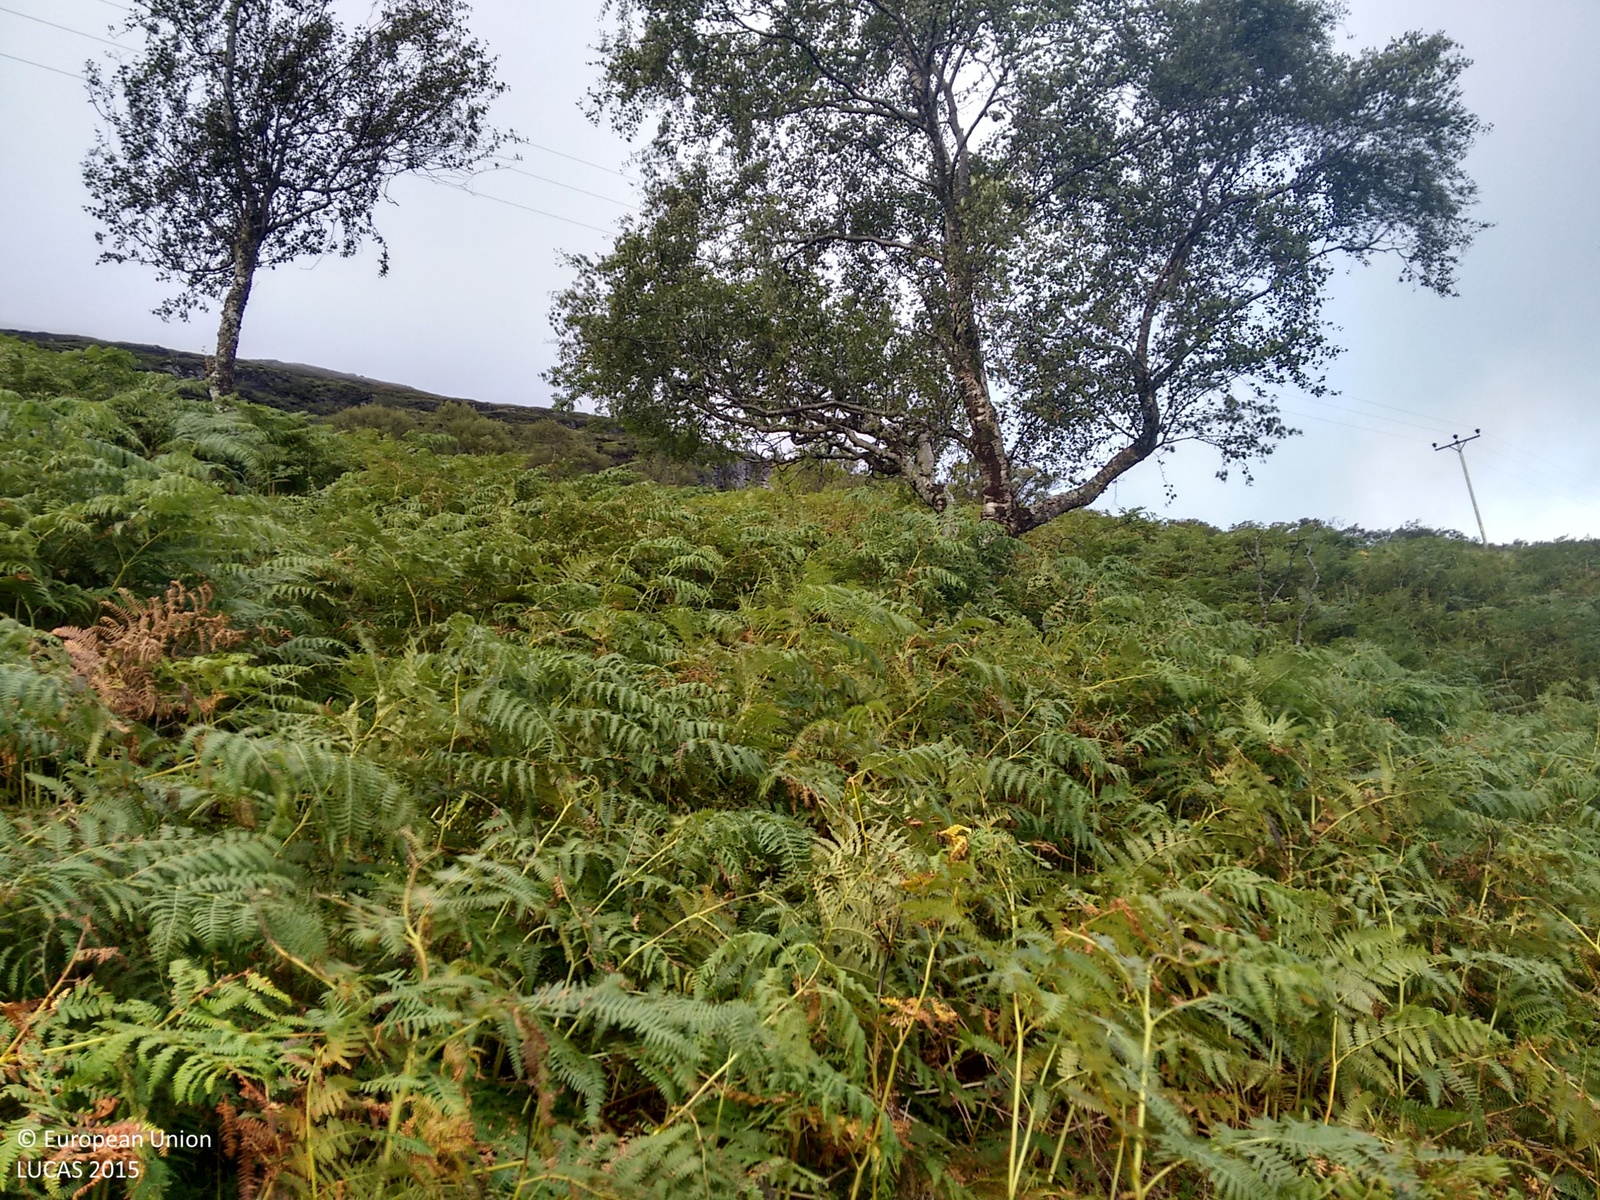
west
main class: Grassland
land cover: Grassland with sparse tree/shrub cover
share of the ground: > 75 %
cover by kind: herbaceous plants 85 %, shrubs 10 %, broadleaved forest trees 5 %
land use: Semi-natural and natural areas not in use
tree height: > 5 m
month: September
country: GB
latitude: 58.2869
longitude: -4.8477
